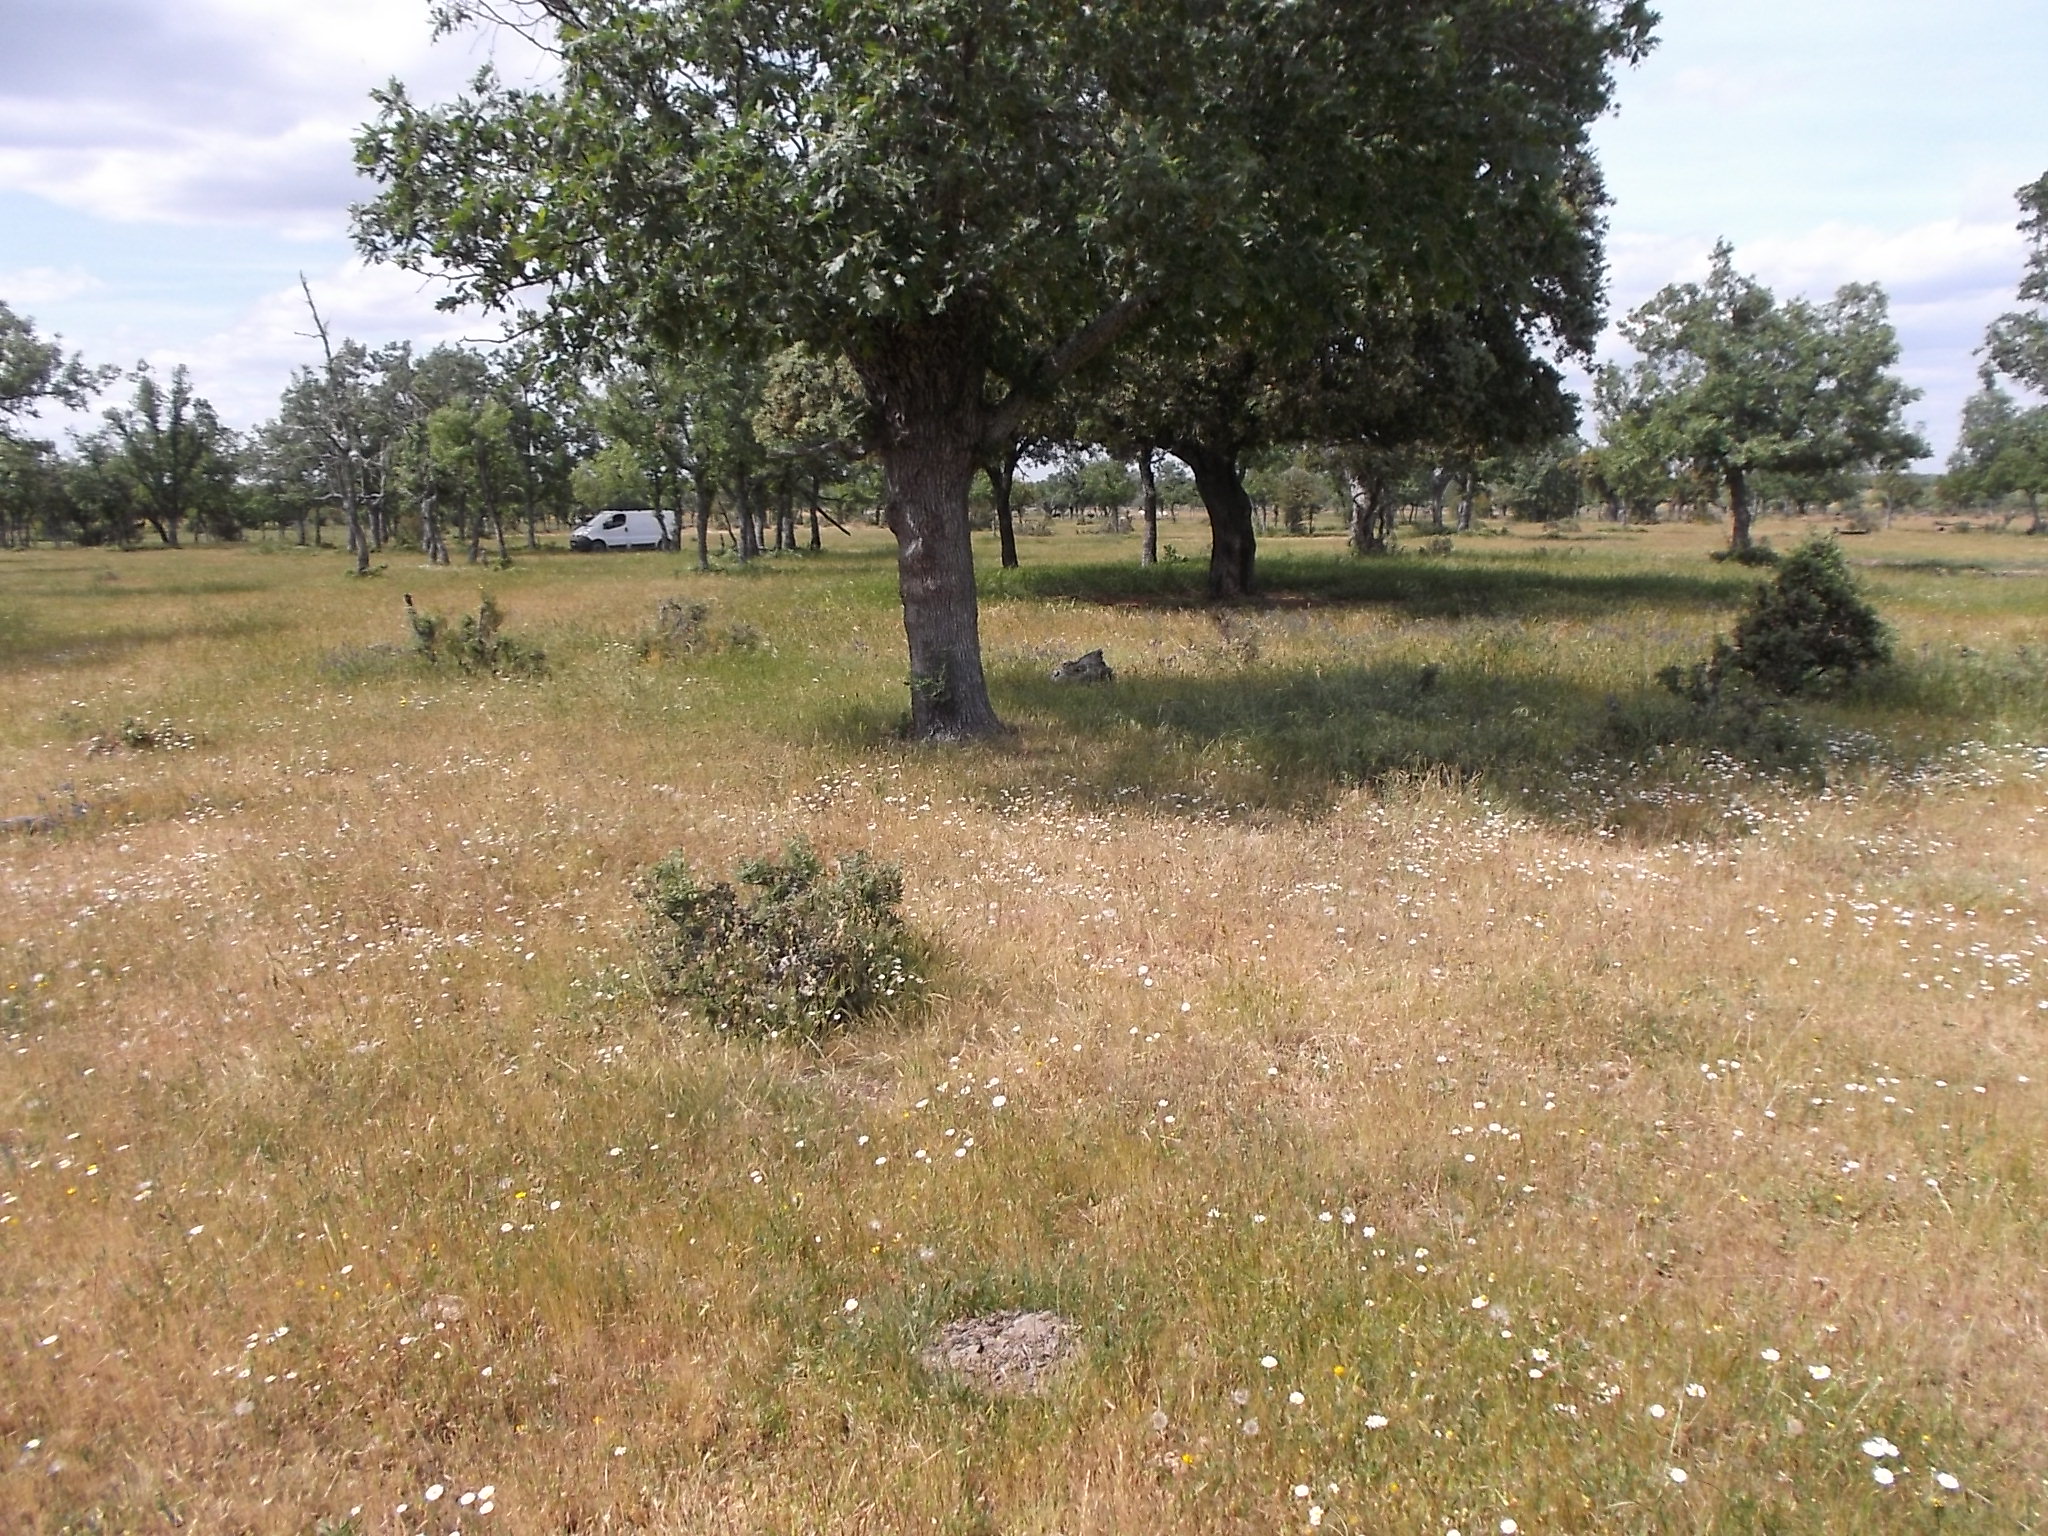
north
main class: Grassland
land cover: Grassland with sparse tree/shrub cover
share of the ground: > 75 %
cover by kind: herbaceous plants 90 %, broadleaved forest trees 5 %, shrubs 5 %
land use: Agriculture (excluding fallow land and kitchen gardens)
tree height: < 5 m
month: May
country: ES
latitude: 41.1205
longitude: -6.3025
